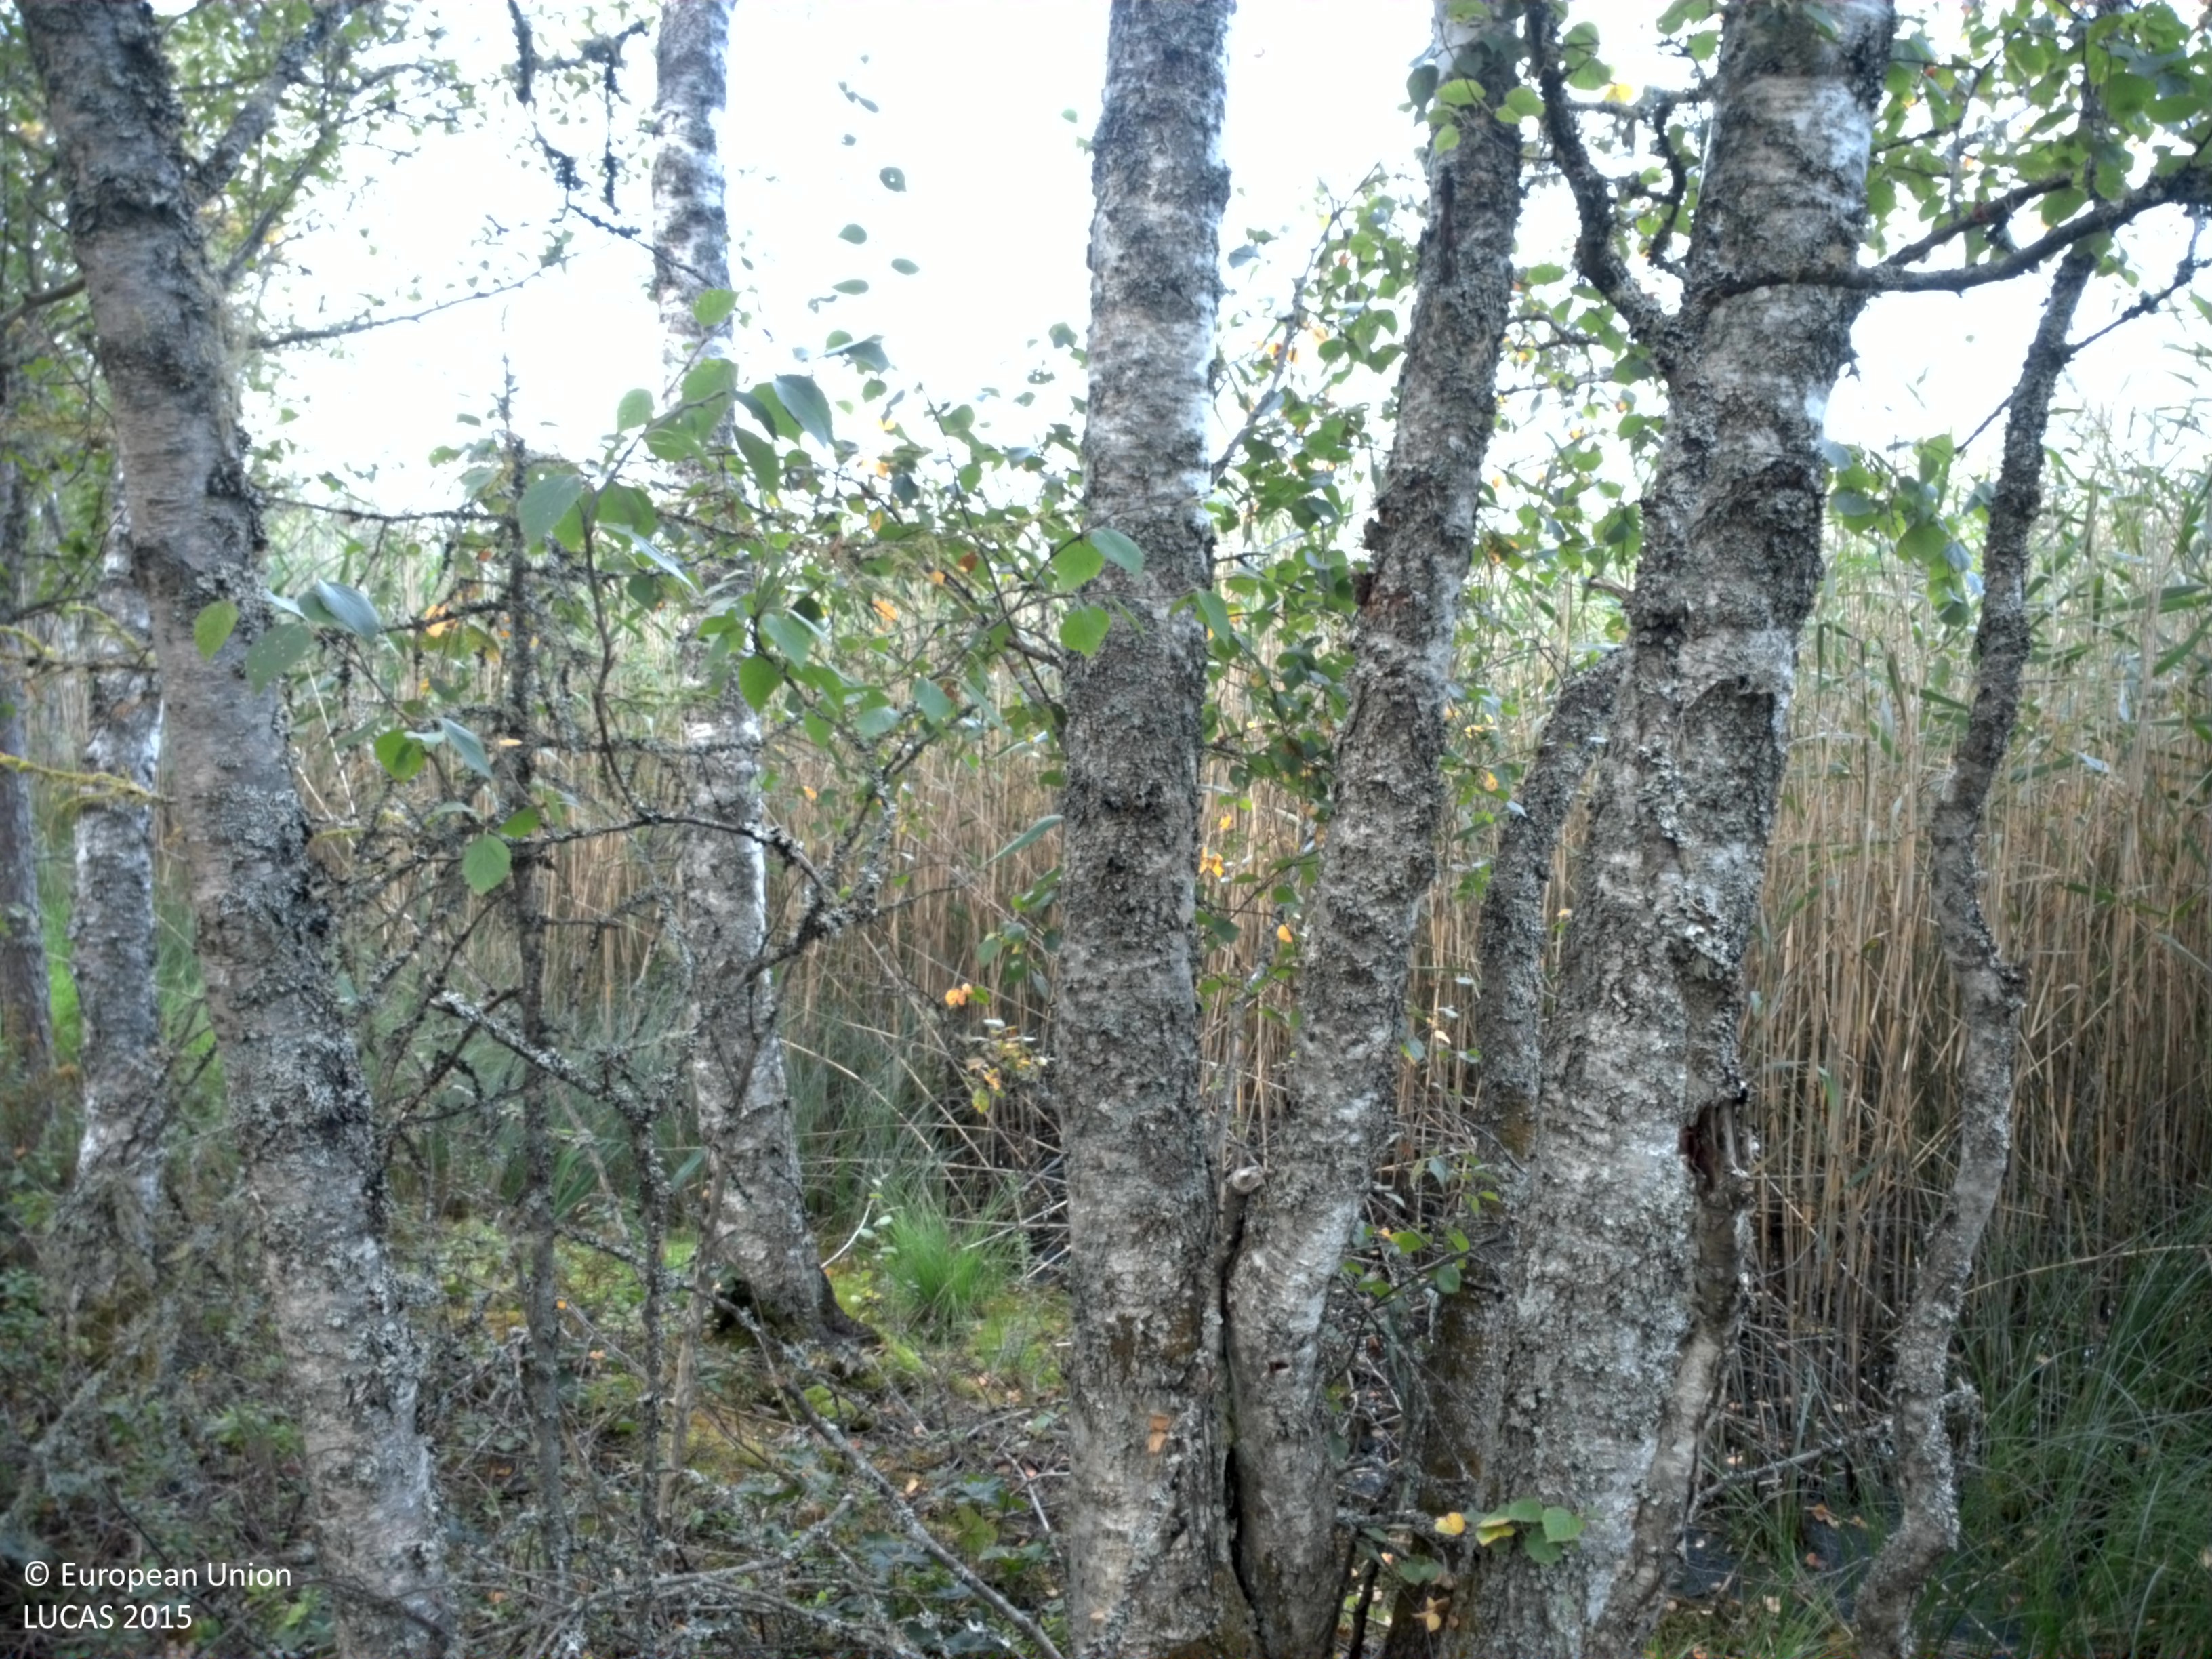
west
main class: Woodland
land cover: Pine dominated coniferous woodland
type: boreal forest
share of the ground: 50 - 75 %
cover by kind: coniferous forest trees 55 %, shrubs 20 %, broadleaved forest trees 10 %, lichens and mosses 10 %, herbaceous plants 5 %
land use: Forestry
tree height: > 5 m
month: August
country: SE
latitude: 59.5801
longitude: 13.4445
